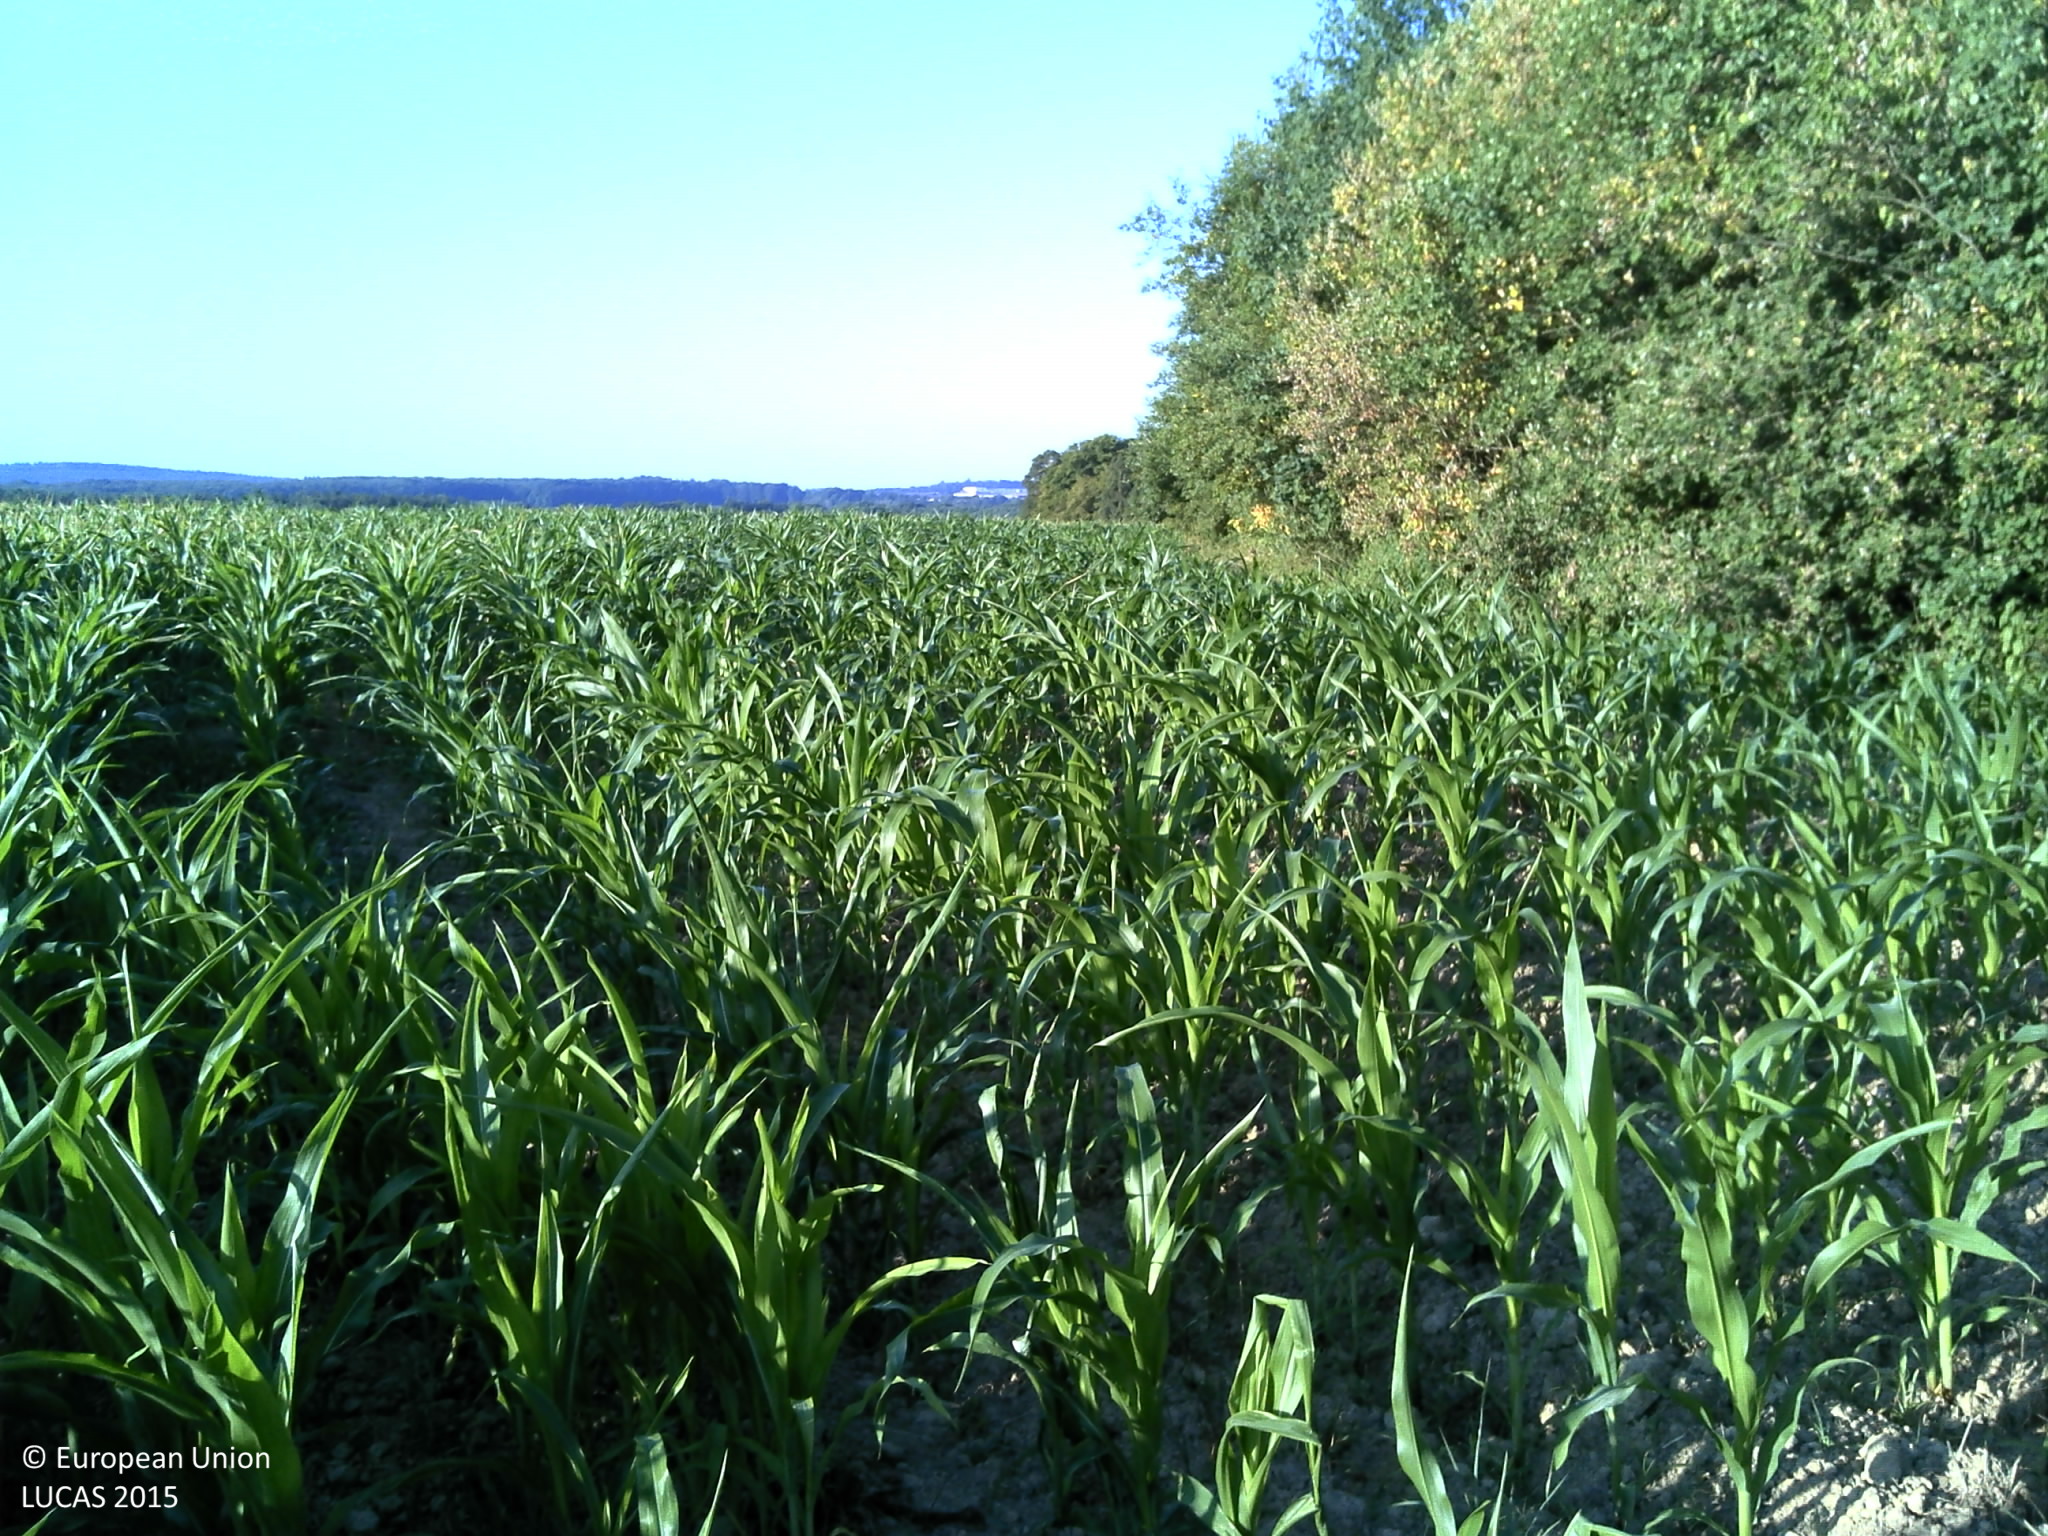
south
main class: Cropland
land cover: Maize
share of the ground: 50 - 75 %
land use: Agriculture (excluding fallow land and kitchen gardens)
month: July
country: FR
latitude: 48.2422
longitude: 6.5670
